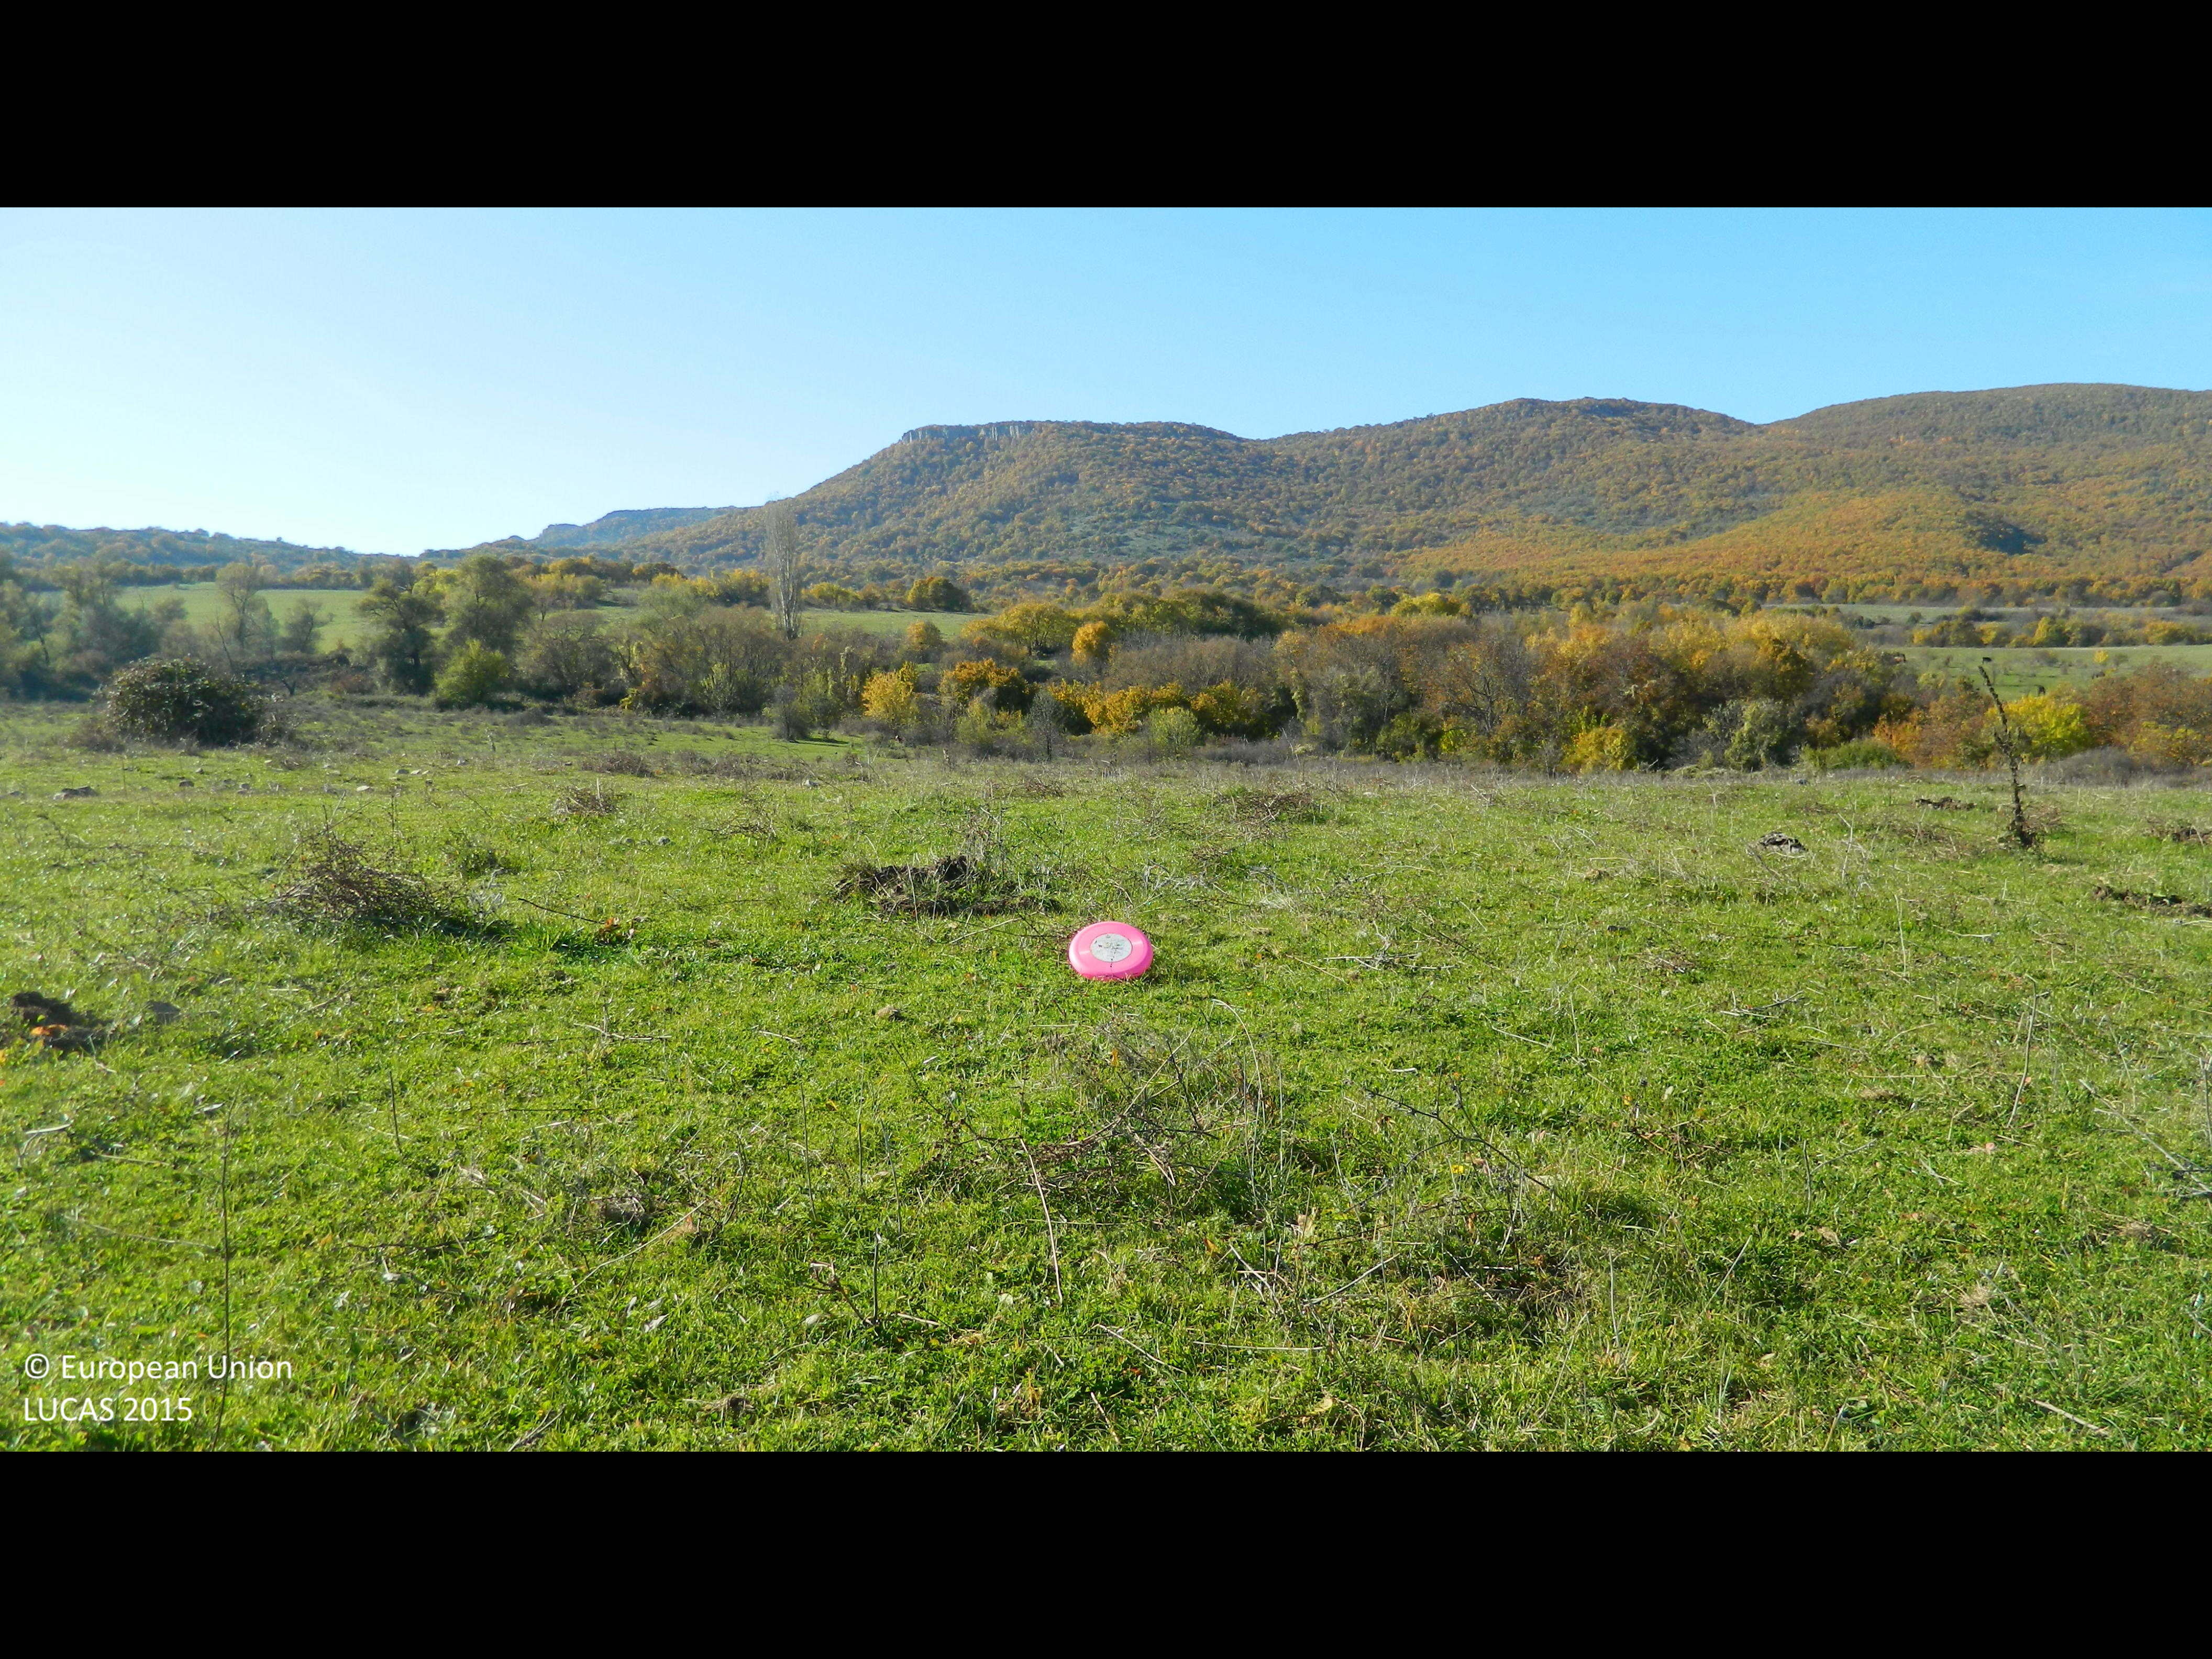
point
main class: Grassland
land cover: Grassland without tree/shrub cover
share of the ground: > 75 %
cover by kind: herbaceous plants 100 %
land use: Agriculture (excluding fallow land and kitchen gardens)
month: November
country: BG
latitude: 41.6200
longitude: 25.9464
